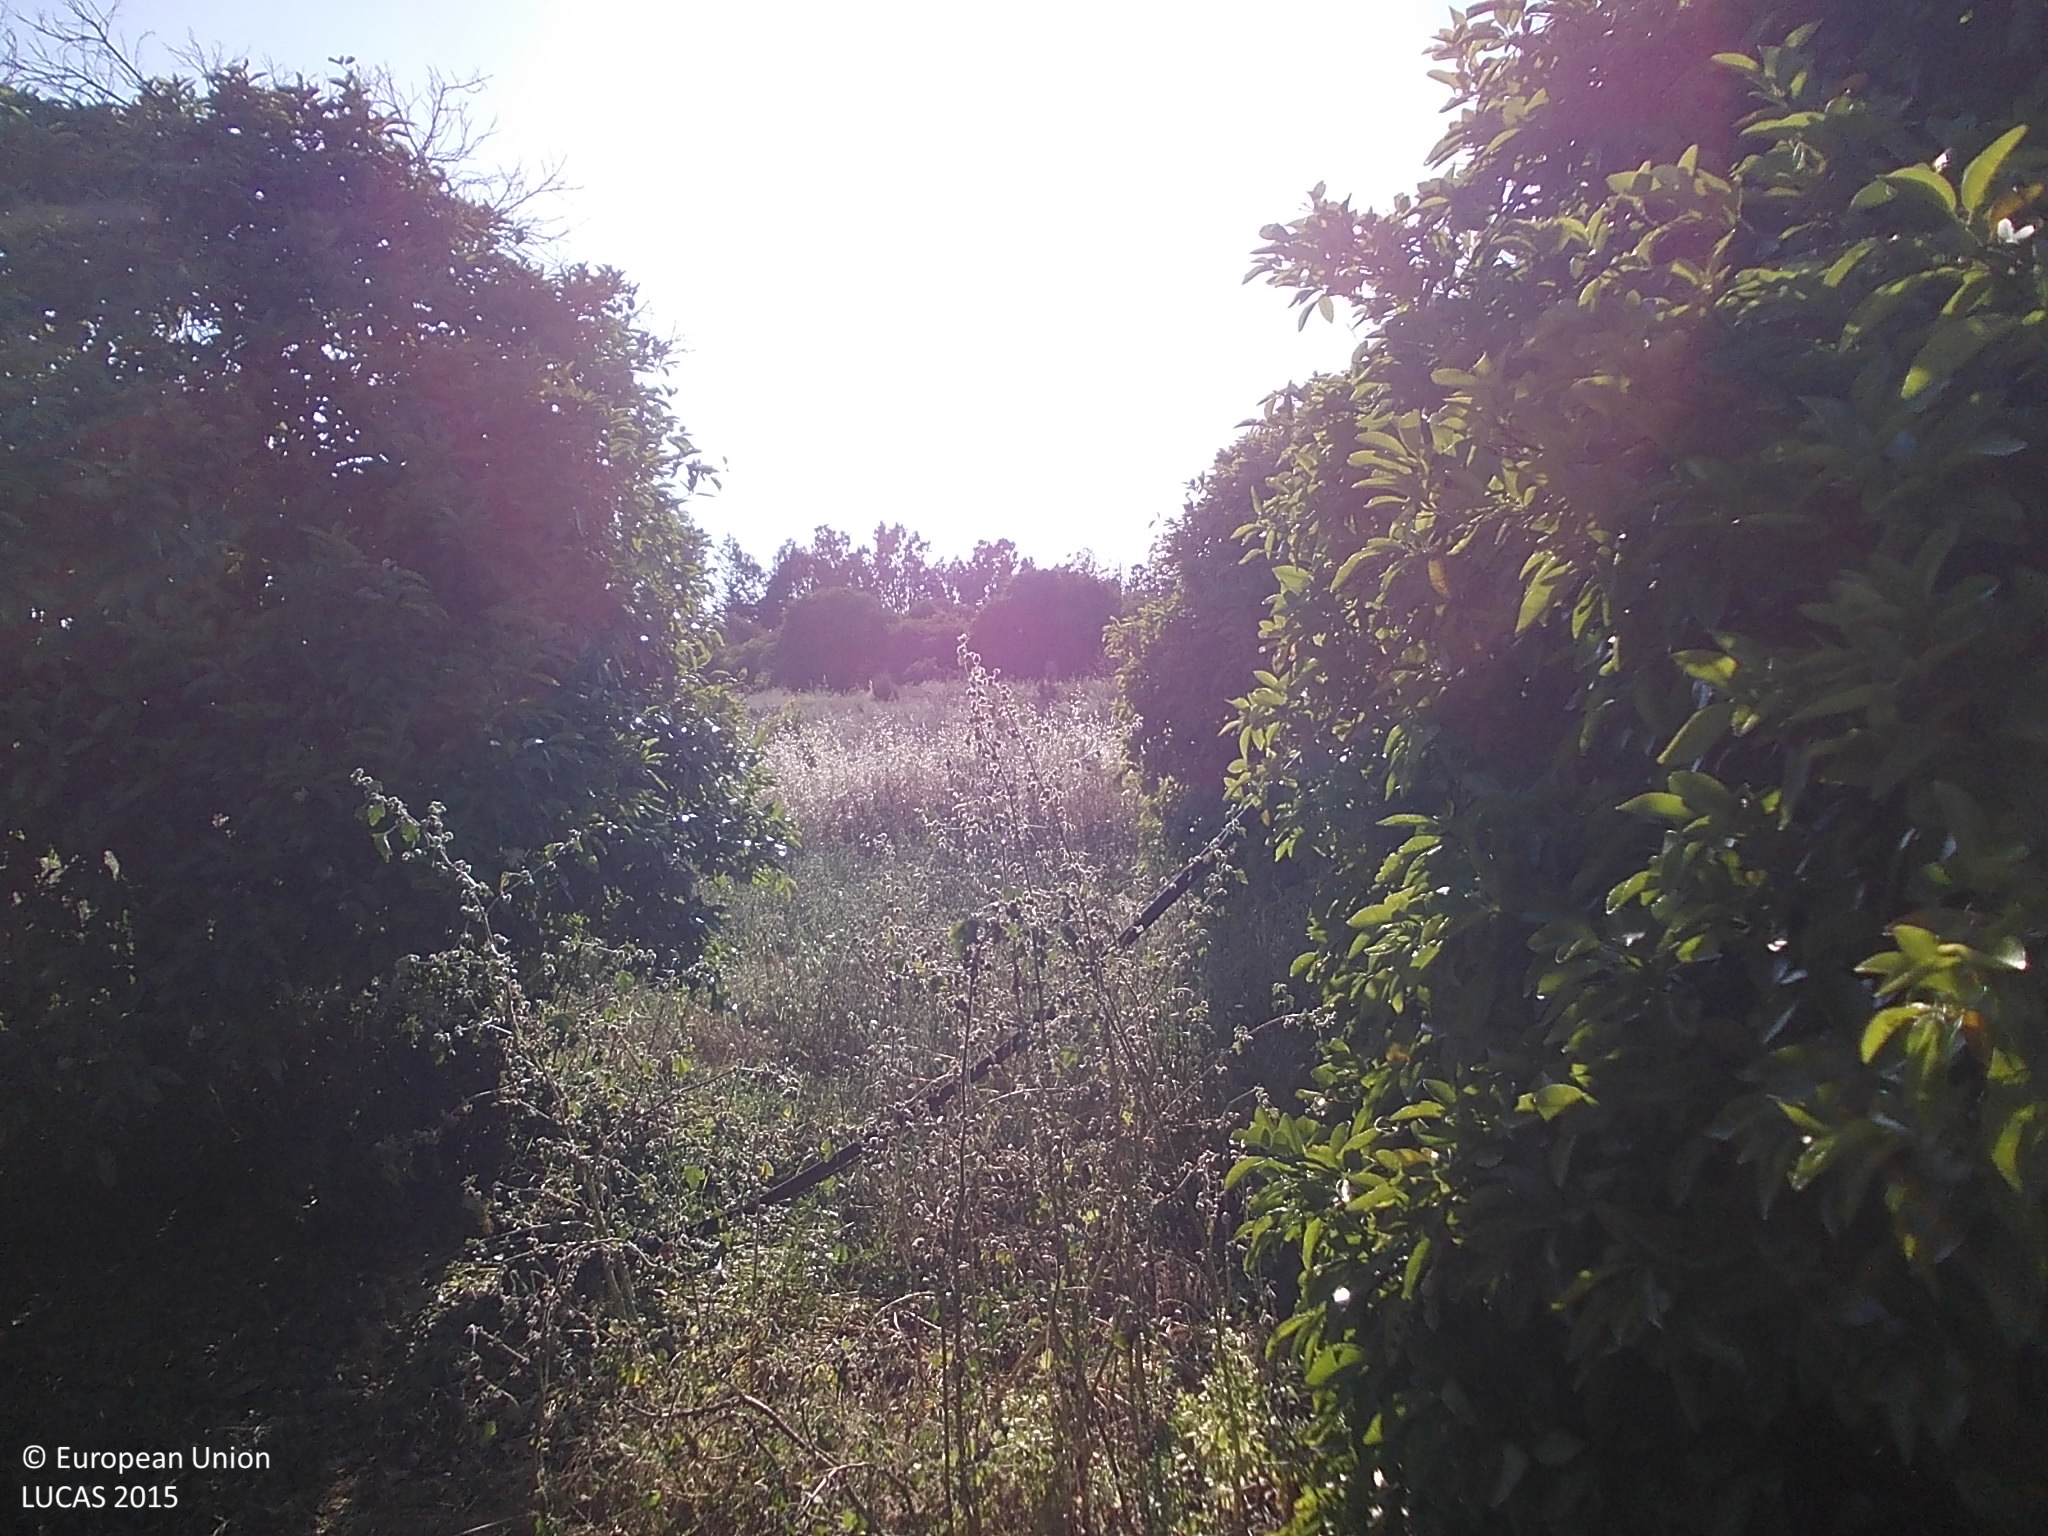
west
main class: Cropland
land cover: Oranges
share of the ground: > 75 %
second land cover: Spontaneously vegetated surfaces
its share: > 75 %
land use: Agriculture (excluding fallow land and kitchen gardens)
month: April
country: CY
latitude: 34.6850
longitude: 32.9862
